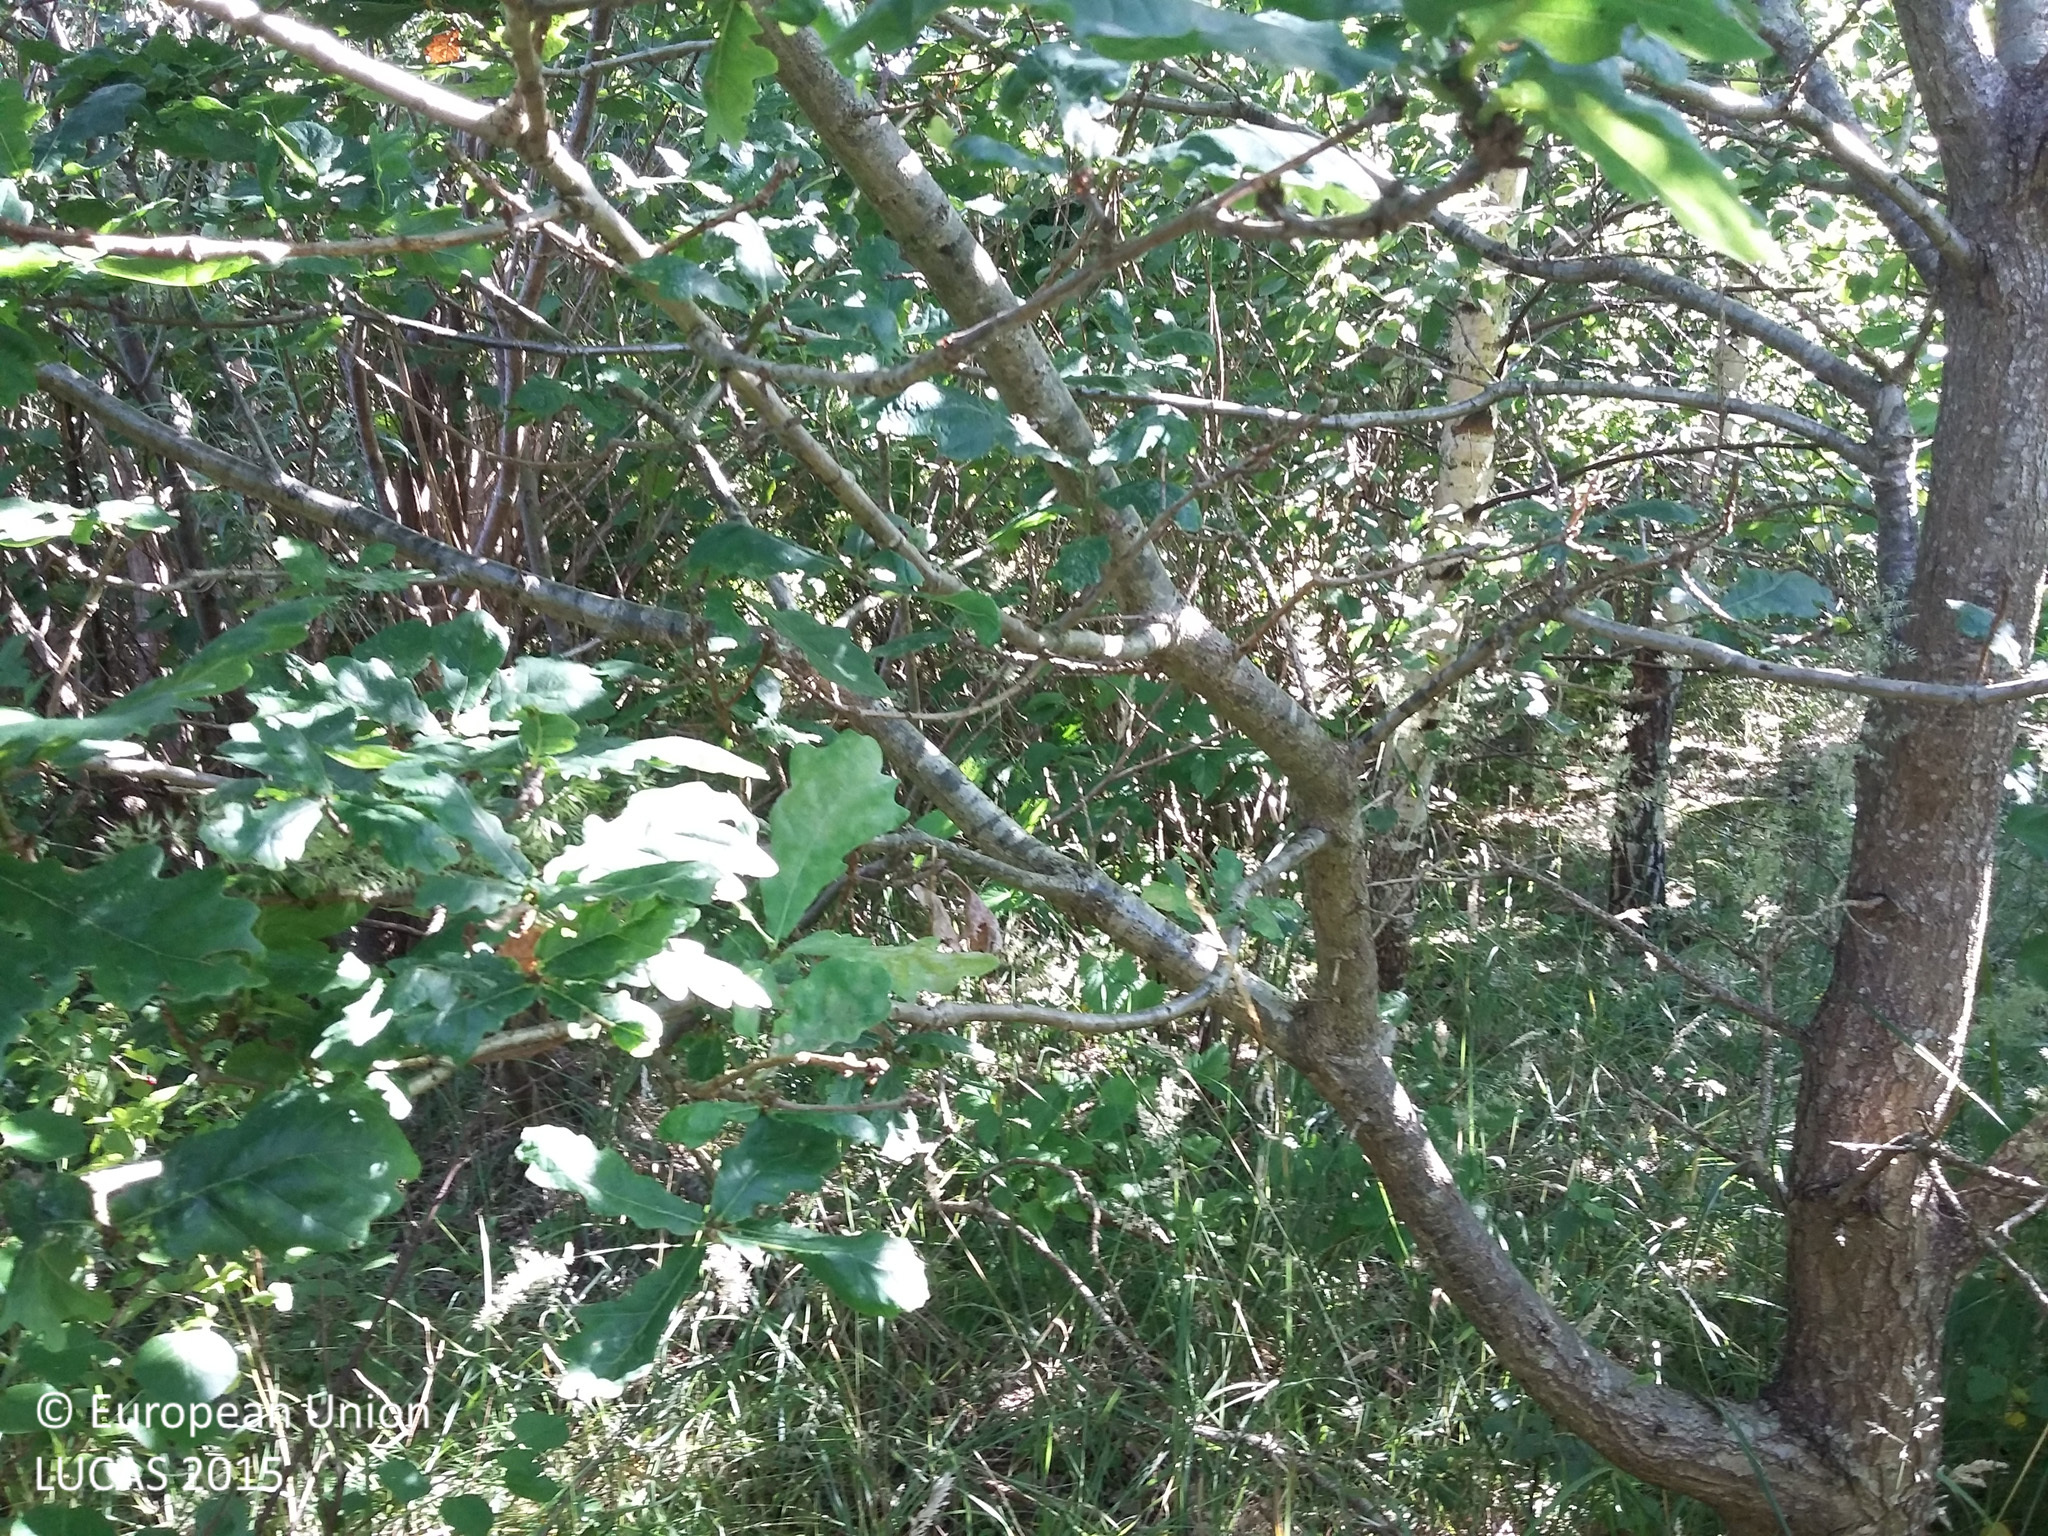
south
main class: Woodland
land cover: Broadleaved woodland
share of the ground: > 75 %
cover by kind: broadleaved forest trees 80 %, herbaceous plants 20 %
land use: Semi-natural and natural areas not in use
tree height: > 5 m
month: August
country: DK
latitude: 55.6849
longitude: 12.1136
